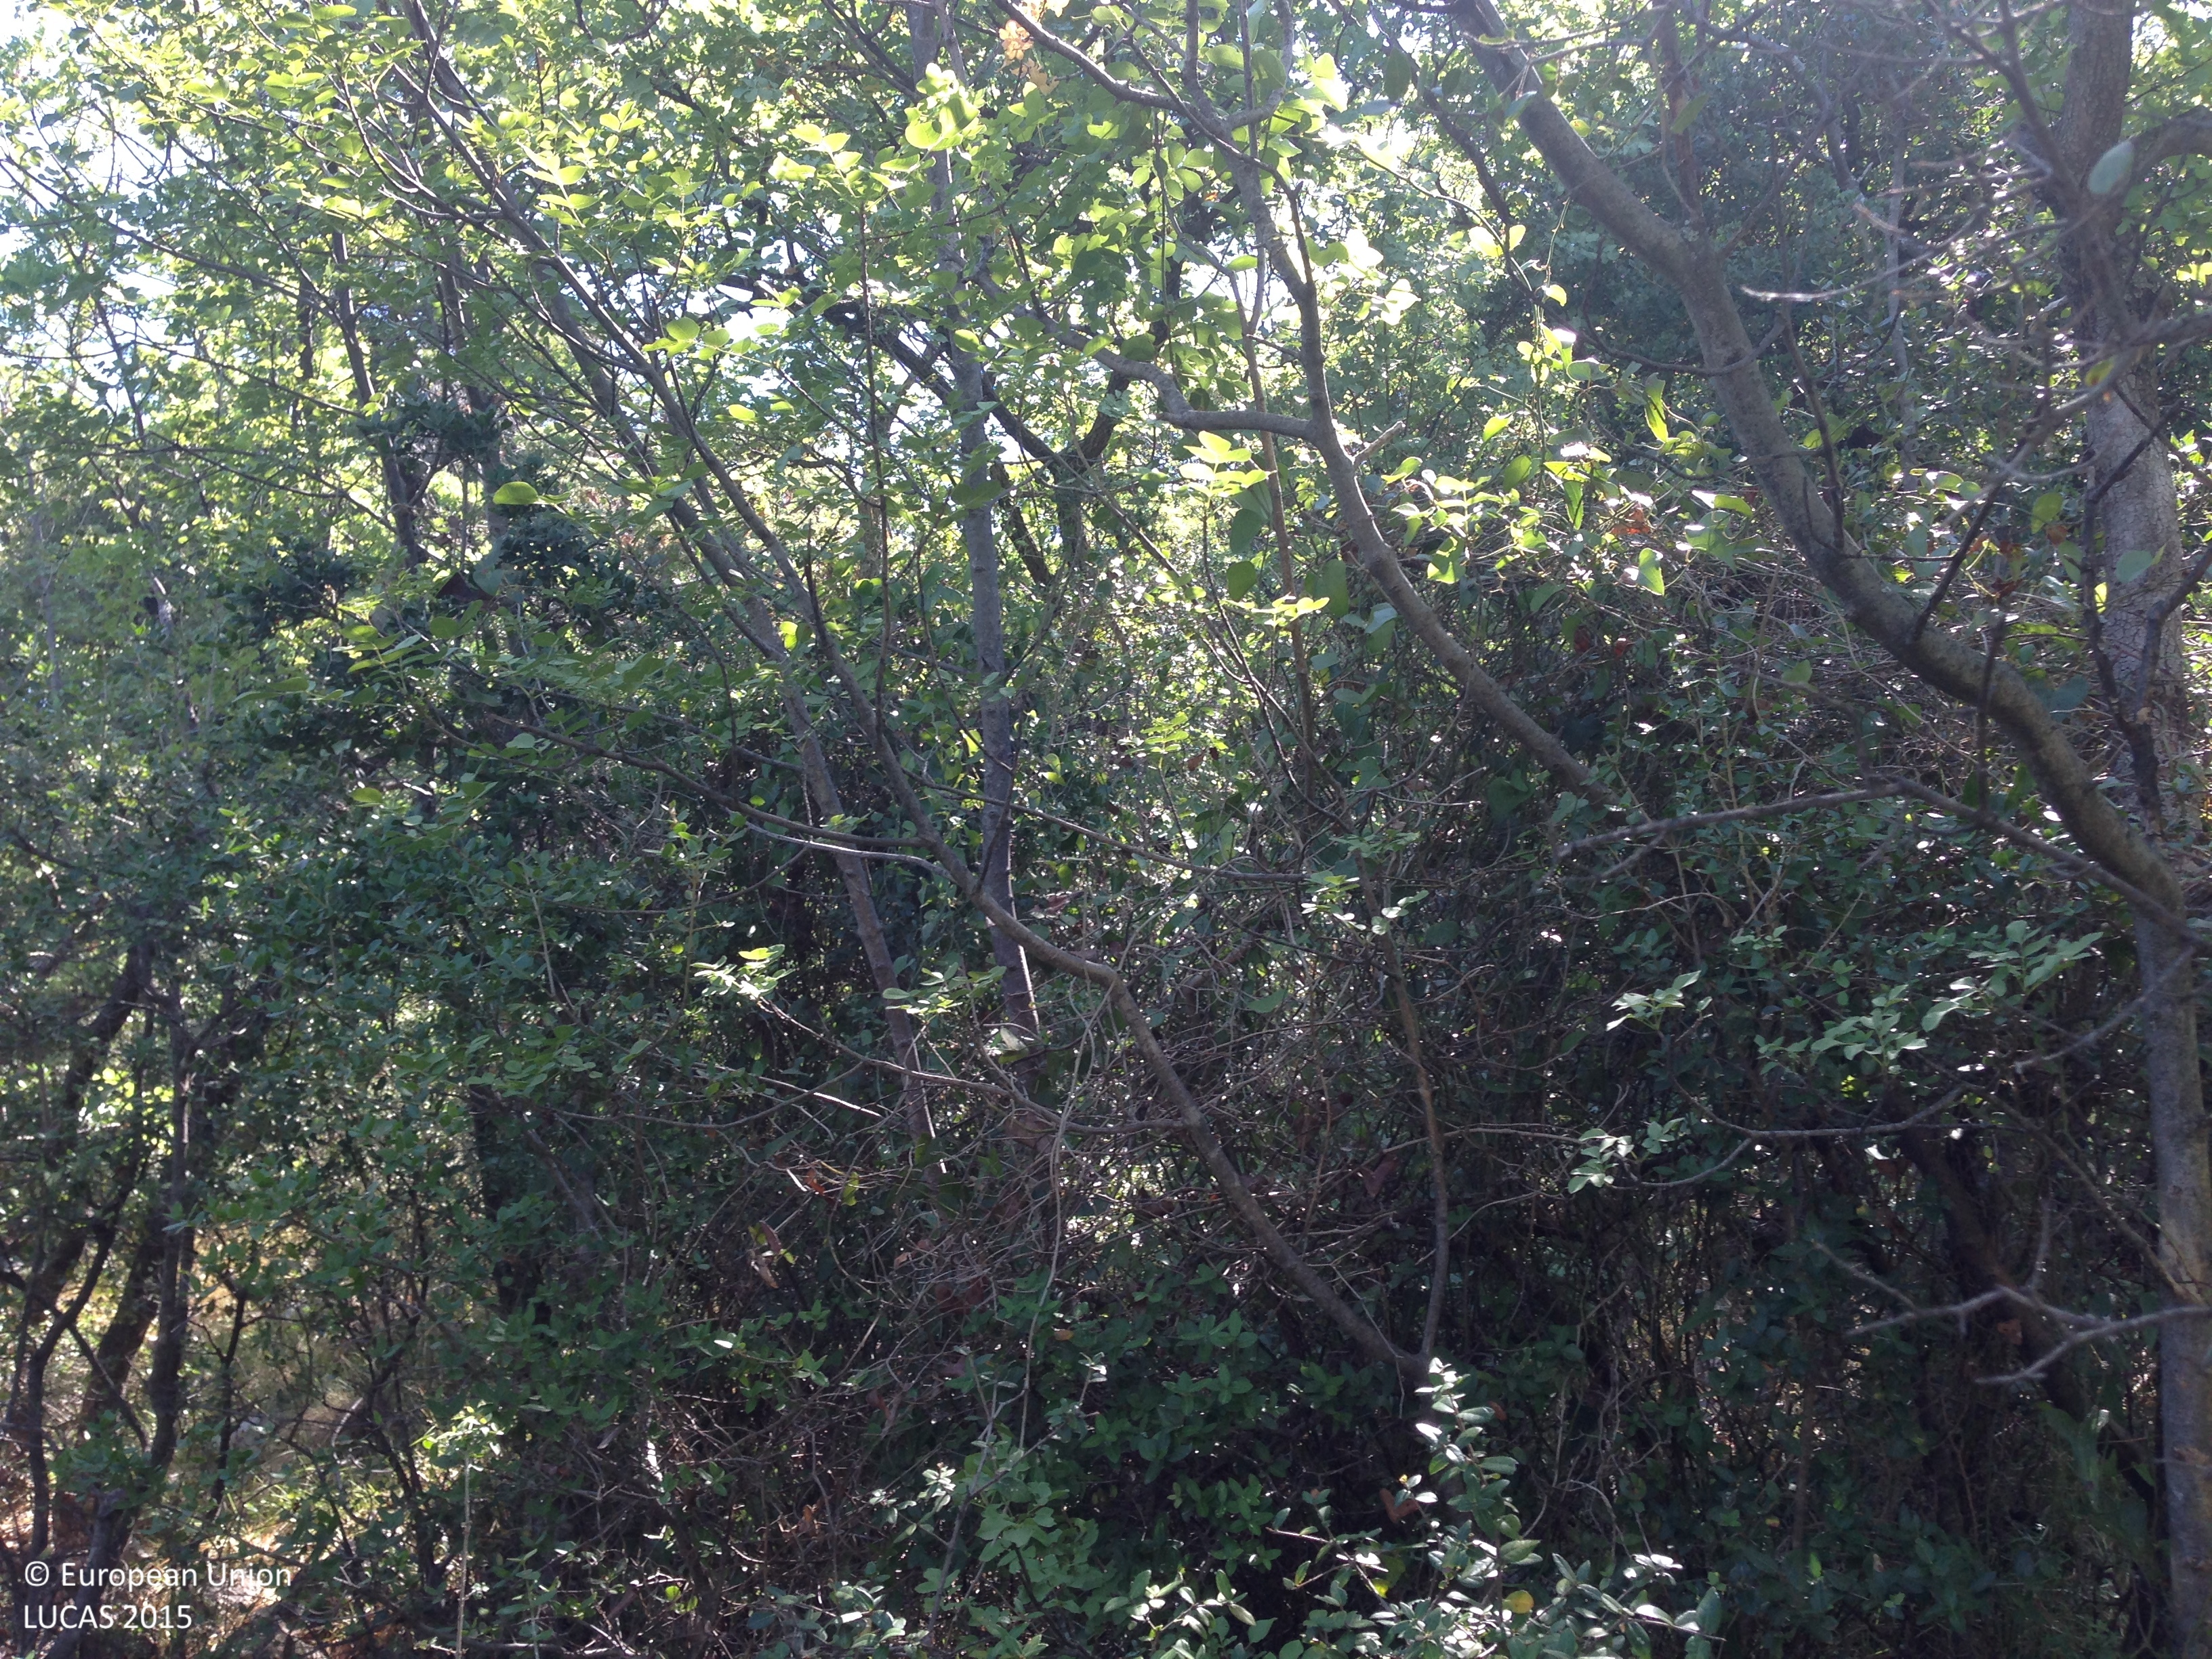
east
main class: Woodland
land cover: Broadleaved woodland
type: thermophilous deciduous forest
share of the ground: 25 - 50 %
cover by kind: broadleaved forest trees 35 %, shrubs 20 %, herbaceous plants 20 %, consolidated bare surface 20 %, unconsolidated bare surface 5 %
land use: Semi-natural and natural areas not in use
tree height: < 5 m
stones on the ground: 10 - 25 %
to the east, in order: Broadleaved woodland; Dry stone walls; Broadleaved woodland; Dry stone walls; Broadleaved woodland; Tracks; Dry stone walls; Broadleaved woodland; Dry stone walls; Broadleaved woodland; Dry stone walls; Broadleaved woodland; Dry stone walls; Broadleaved woodland; Dry stone walls; Broadleaved woodland; Dry stone walls; Broadleaved woodland; Dry stone walls; Broadleaved woodland; Dry stone walls; Broadleaved woodland; Dry stone walls; Broadleaved woodland; Dry stone walls; Rocks and stones; Dry stone walls; Rocks and stones; Broadleaved woodland; Tracks; Broadleaved woodland
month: July
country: HR
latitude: 44.7043
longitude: 14.9032
